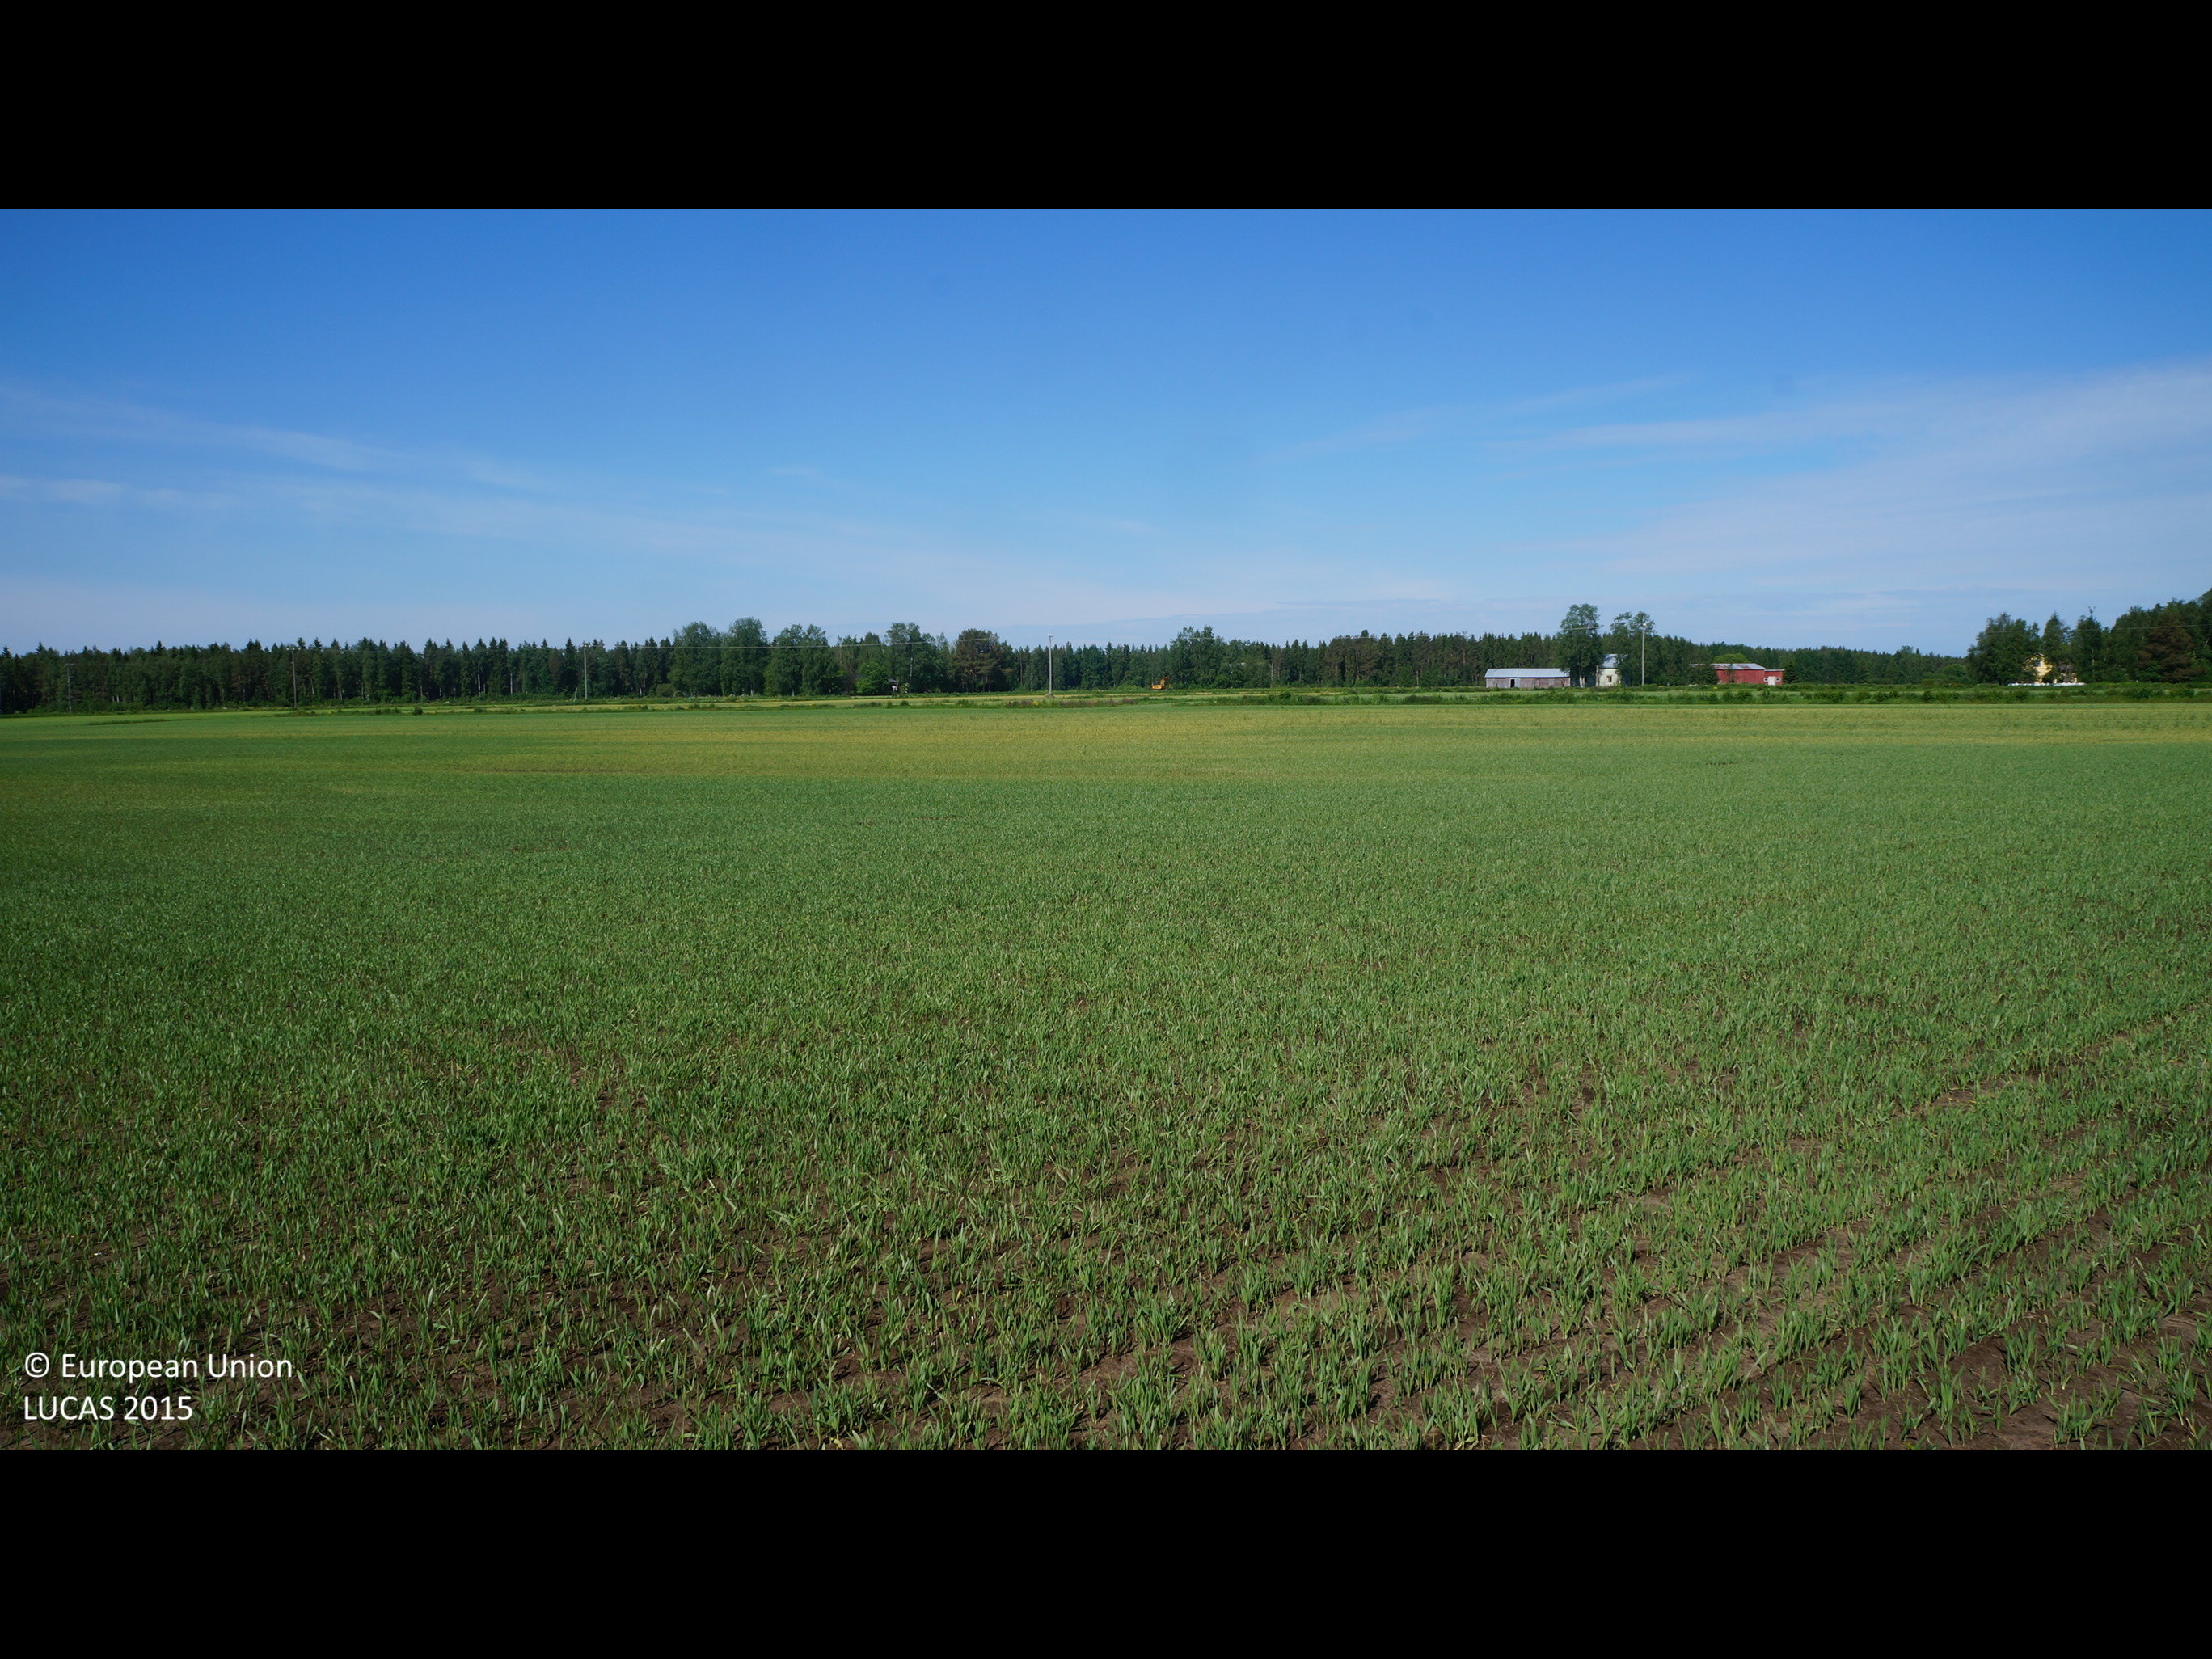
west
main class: Cropland
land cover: Barley
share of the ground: 25 - 50 %
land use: Agriculture (excluding fallow land and kitchen gardens)
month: June
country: FI
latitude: 64.1227
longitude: 23.7992
